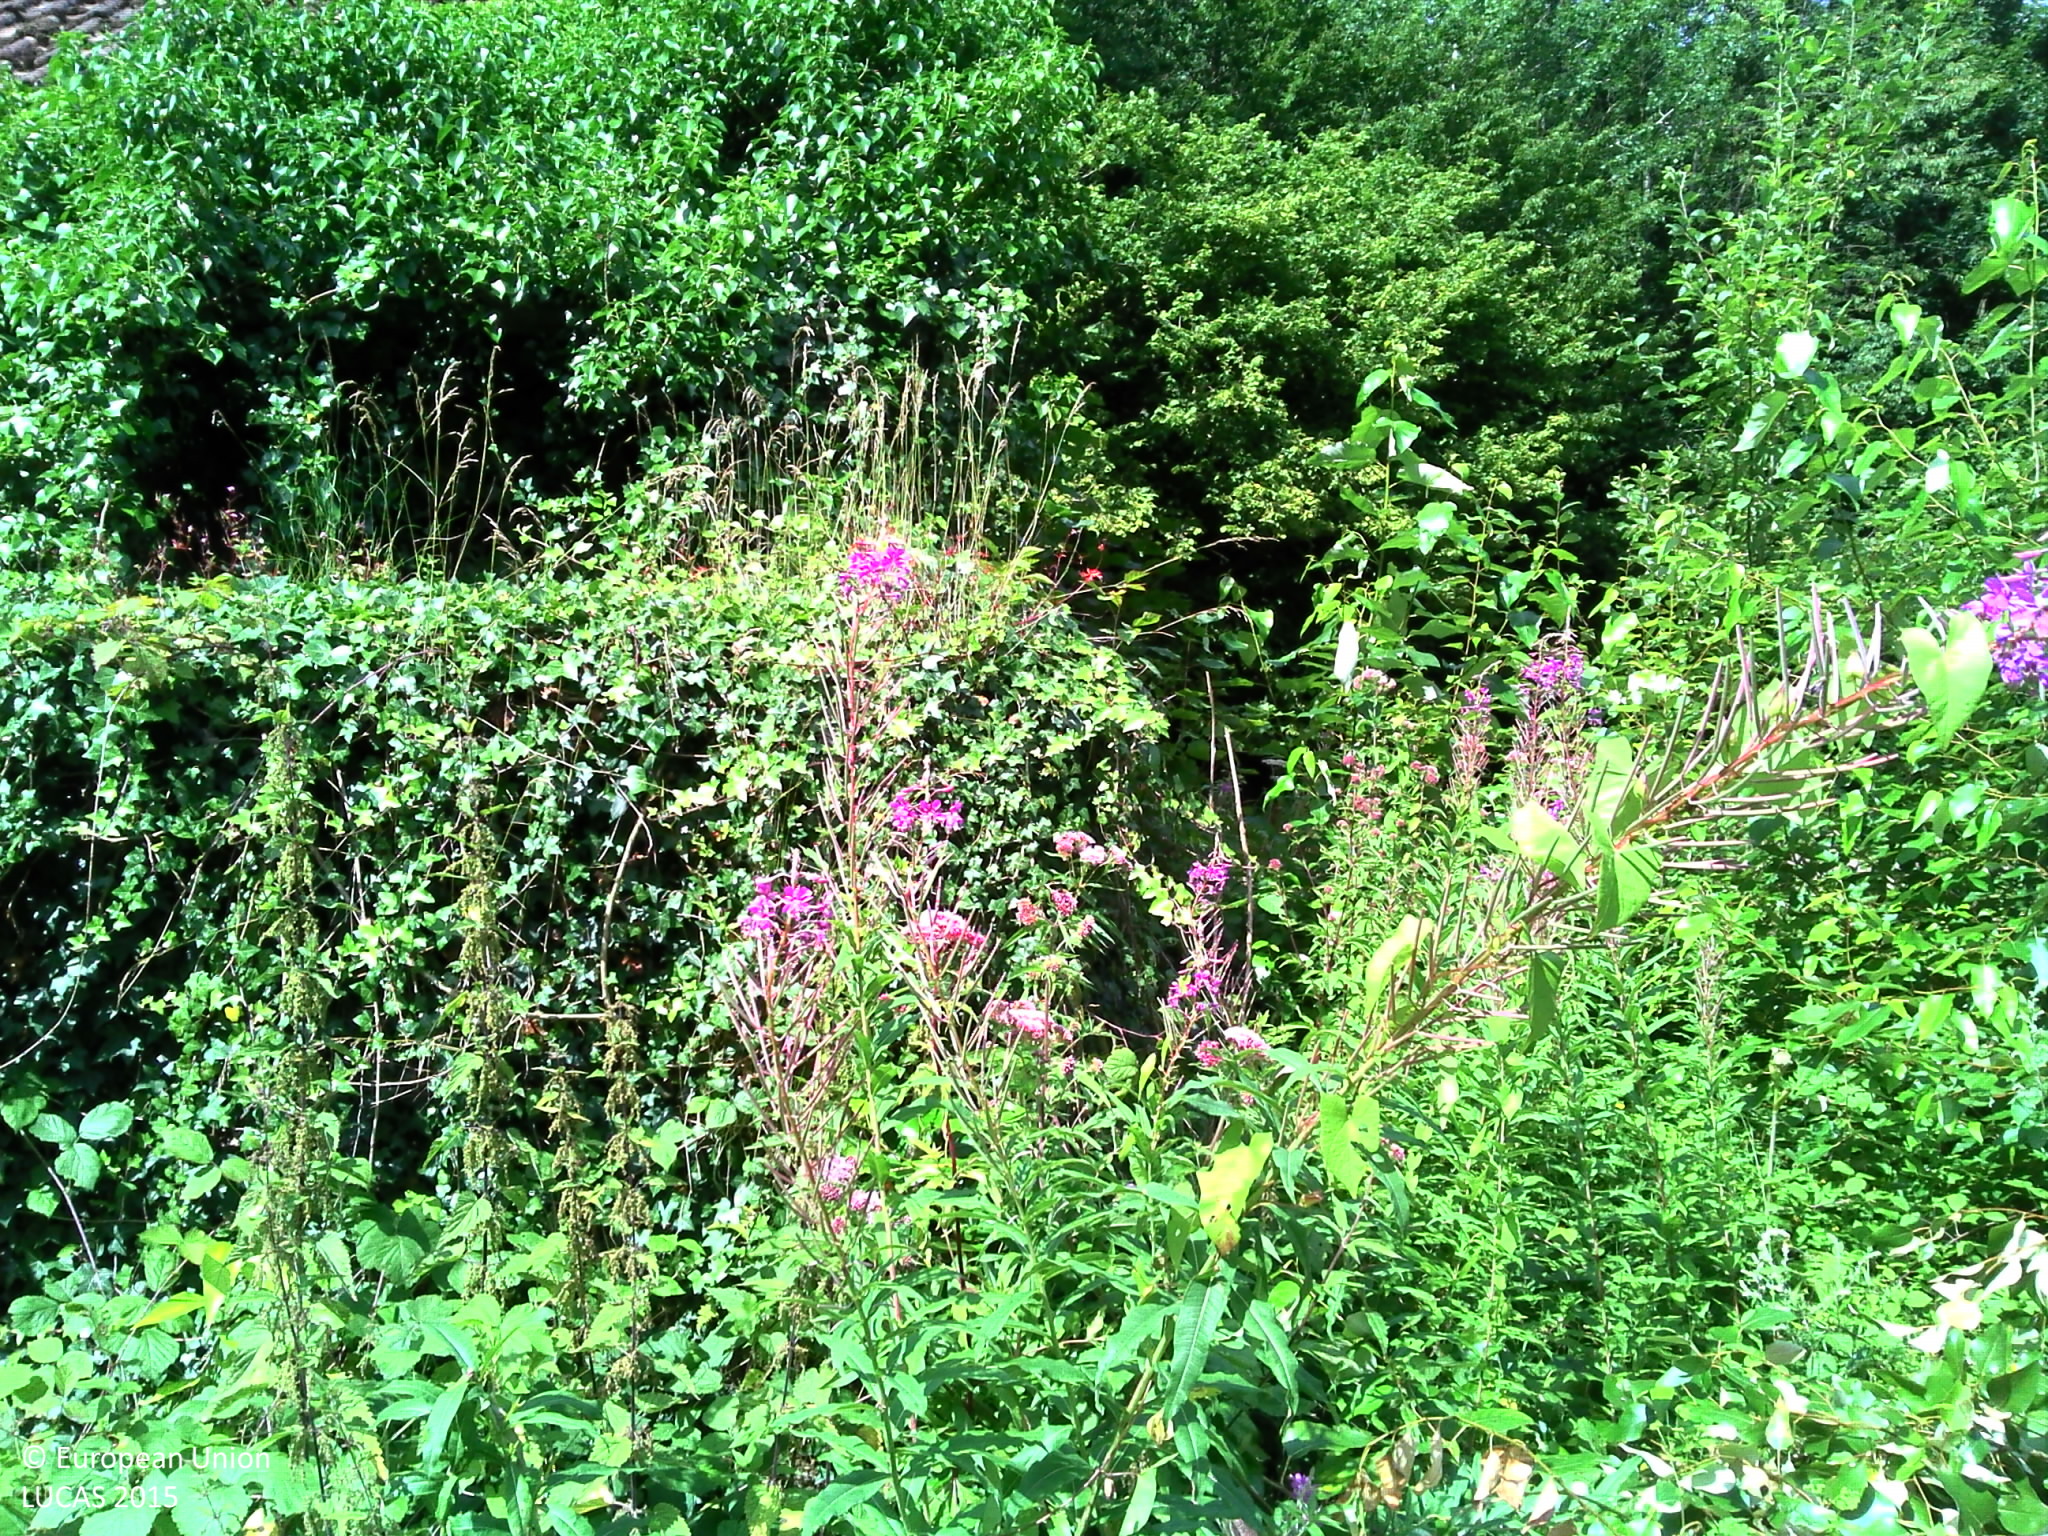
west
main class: Shrubland
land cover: Shrubland with sparse tree cover
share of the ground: > 75 %
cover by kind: shrubs 50 %, herbaceous plants 45 %, broadleaved forest trees 5 %
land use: Semi-natural and natural areas not in use
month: August
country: BE
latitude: 50.3620
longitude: 4.5841
